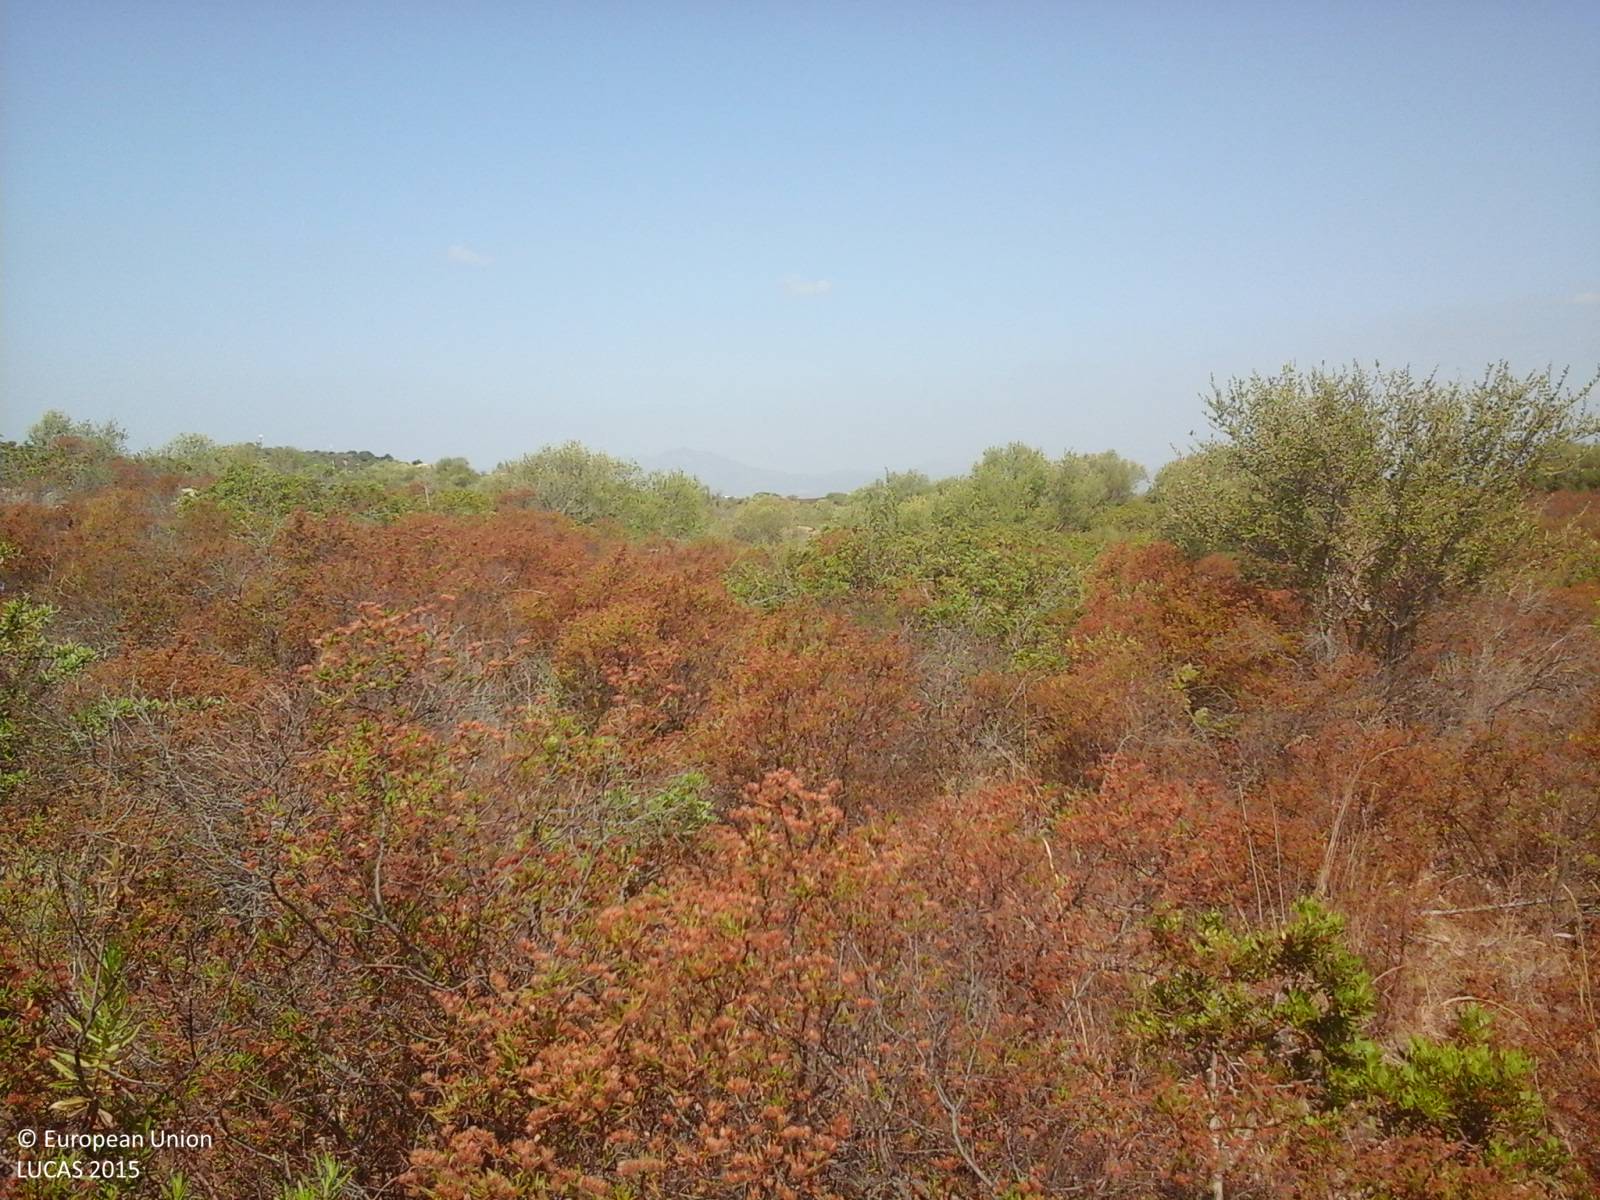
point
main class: Shrubland
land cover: Shrubland without tree cover
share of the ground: > 75 %
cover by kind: shrubs 95 %, unconsolidated bare surface 5 %
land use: Semi-natural and natural areas not in use
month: July
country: IT
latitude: 40.8819
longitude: 9.6102
